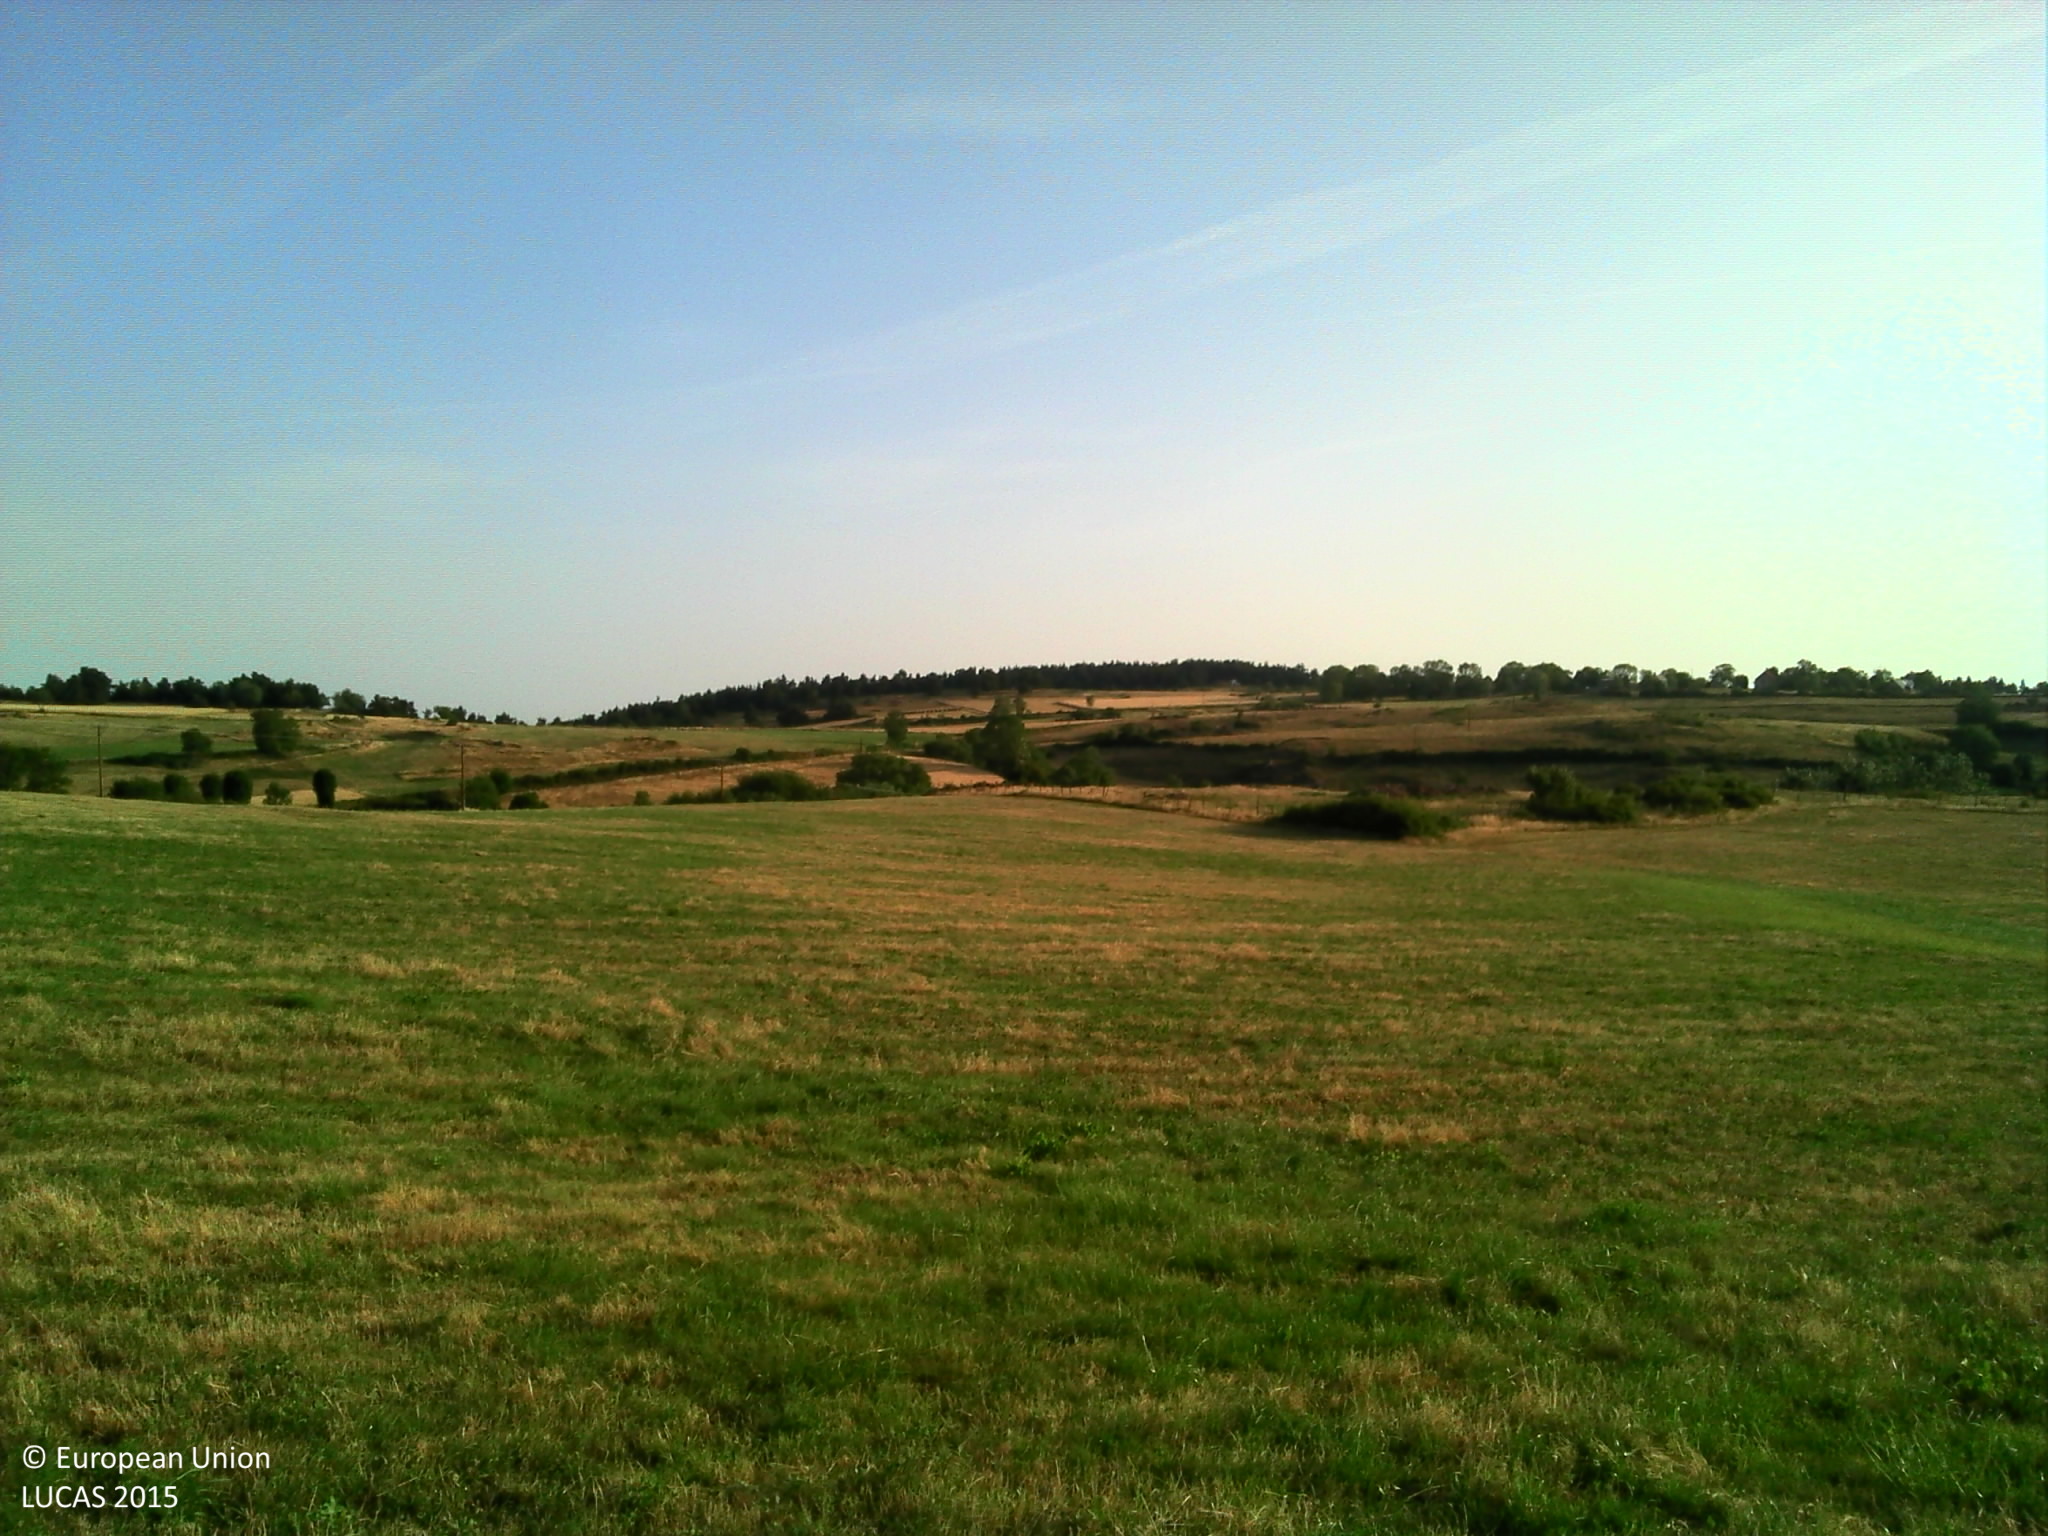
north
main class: Grassland
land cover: Grassland without tree/shrub cover
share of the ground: > 75 %
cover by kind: herbaceous plants 100 %
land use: Agriculture (excluding fallow land and kitchen gardens)
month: July
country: FR
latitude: 45.3327
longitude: 3.0981
